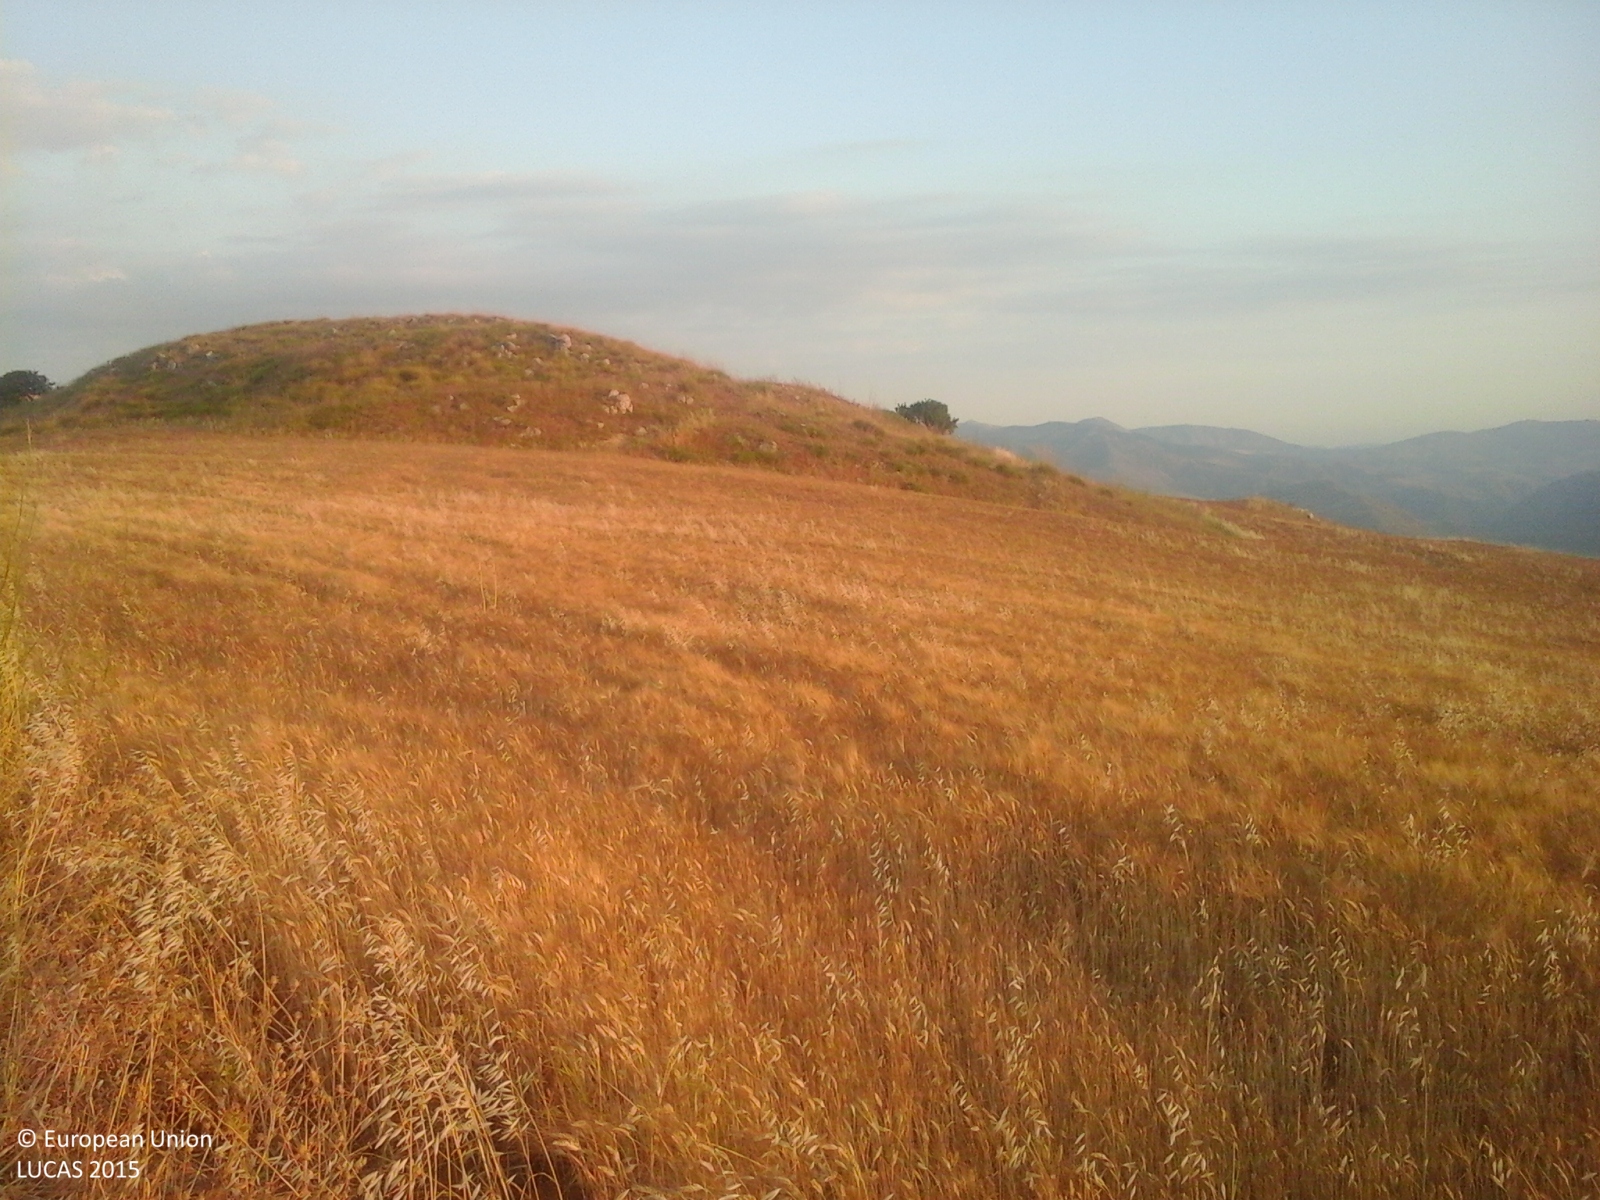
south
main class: Cropland
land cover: Durum wheat
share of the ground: > 75 %
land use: Agriculture (excluding fallow land and kitchen gardens)
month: July
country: IT
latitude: 37.5207
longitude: 13.4699
